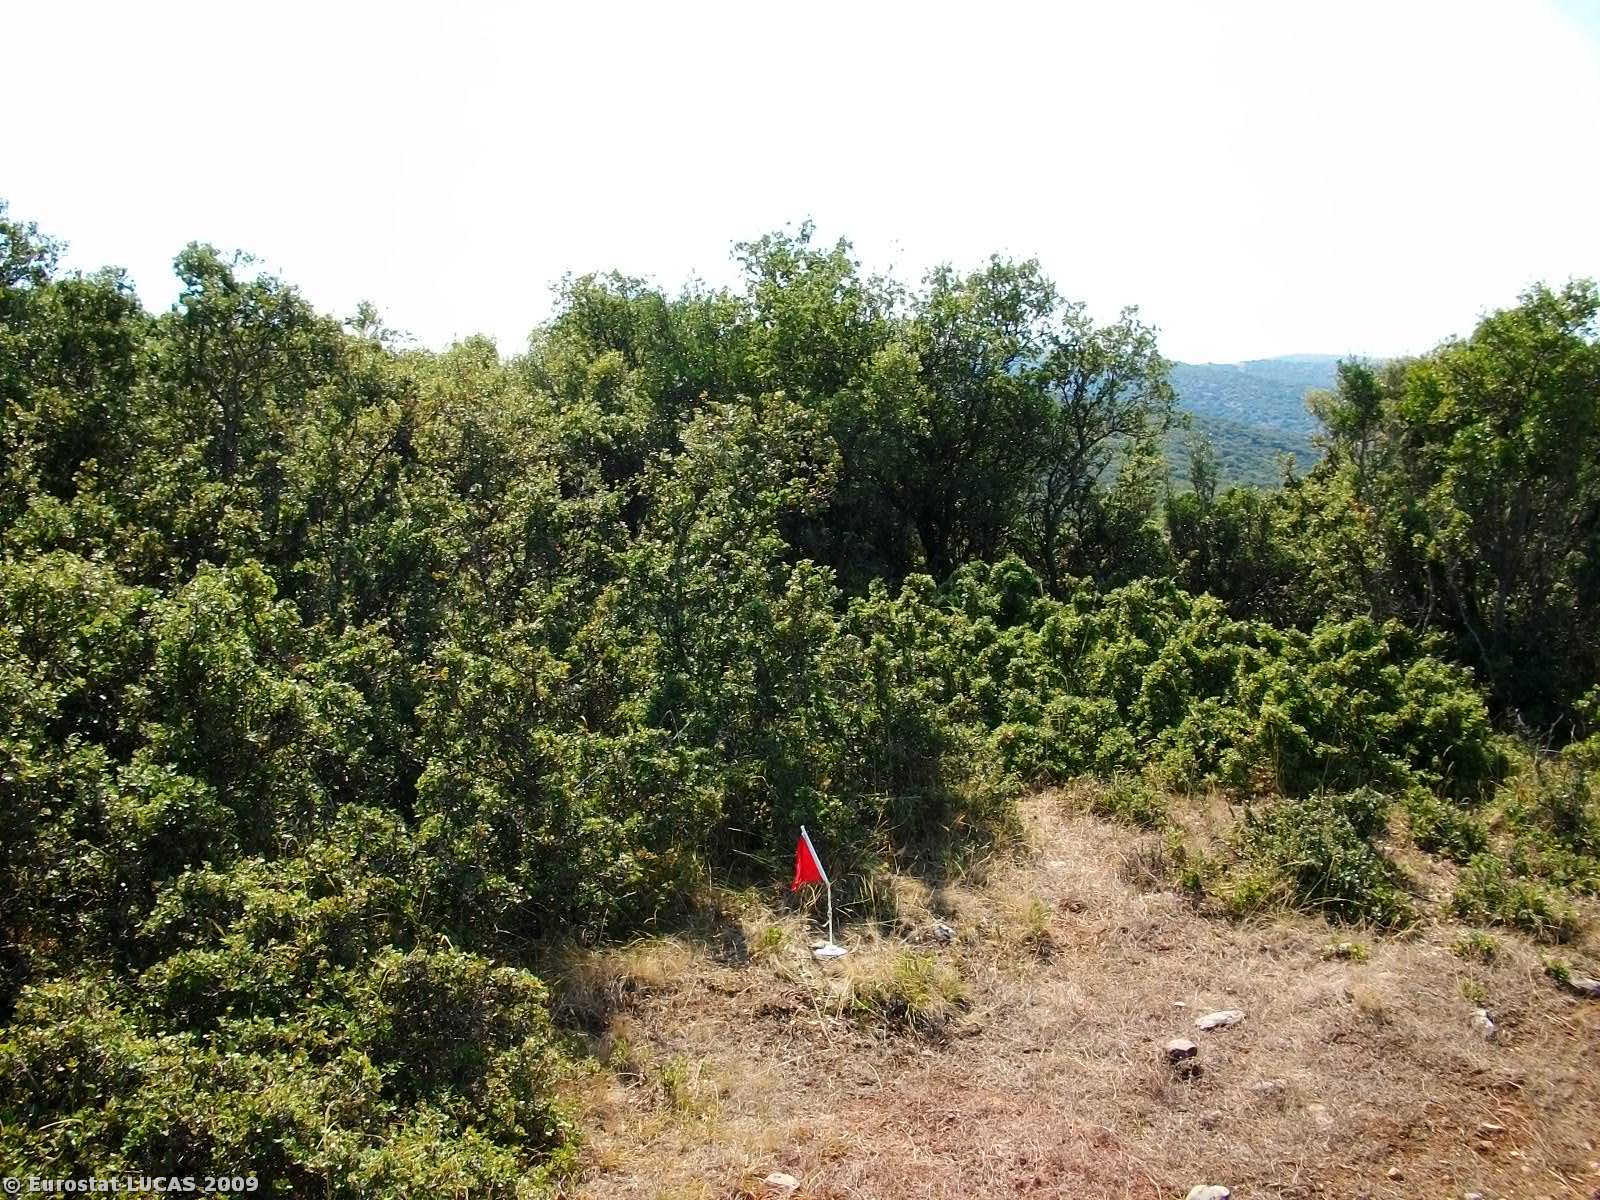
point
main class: Shrubland
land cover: Shrubland without tree cover
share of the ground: > 75 %
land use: Unused
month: July
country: GR
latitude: 40.1566
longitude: 21.7891
